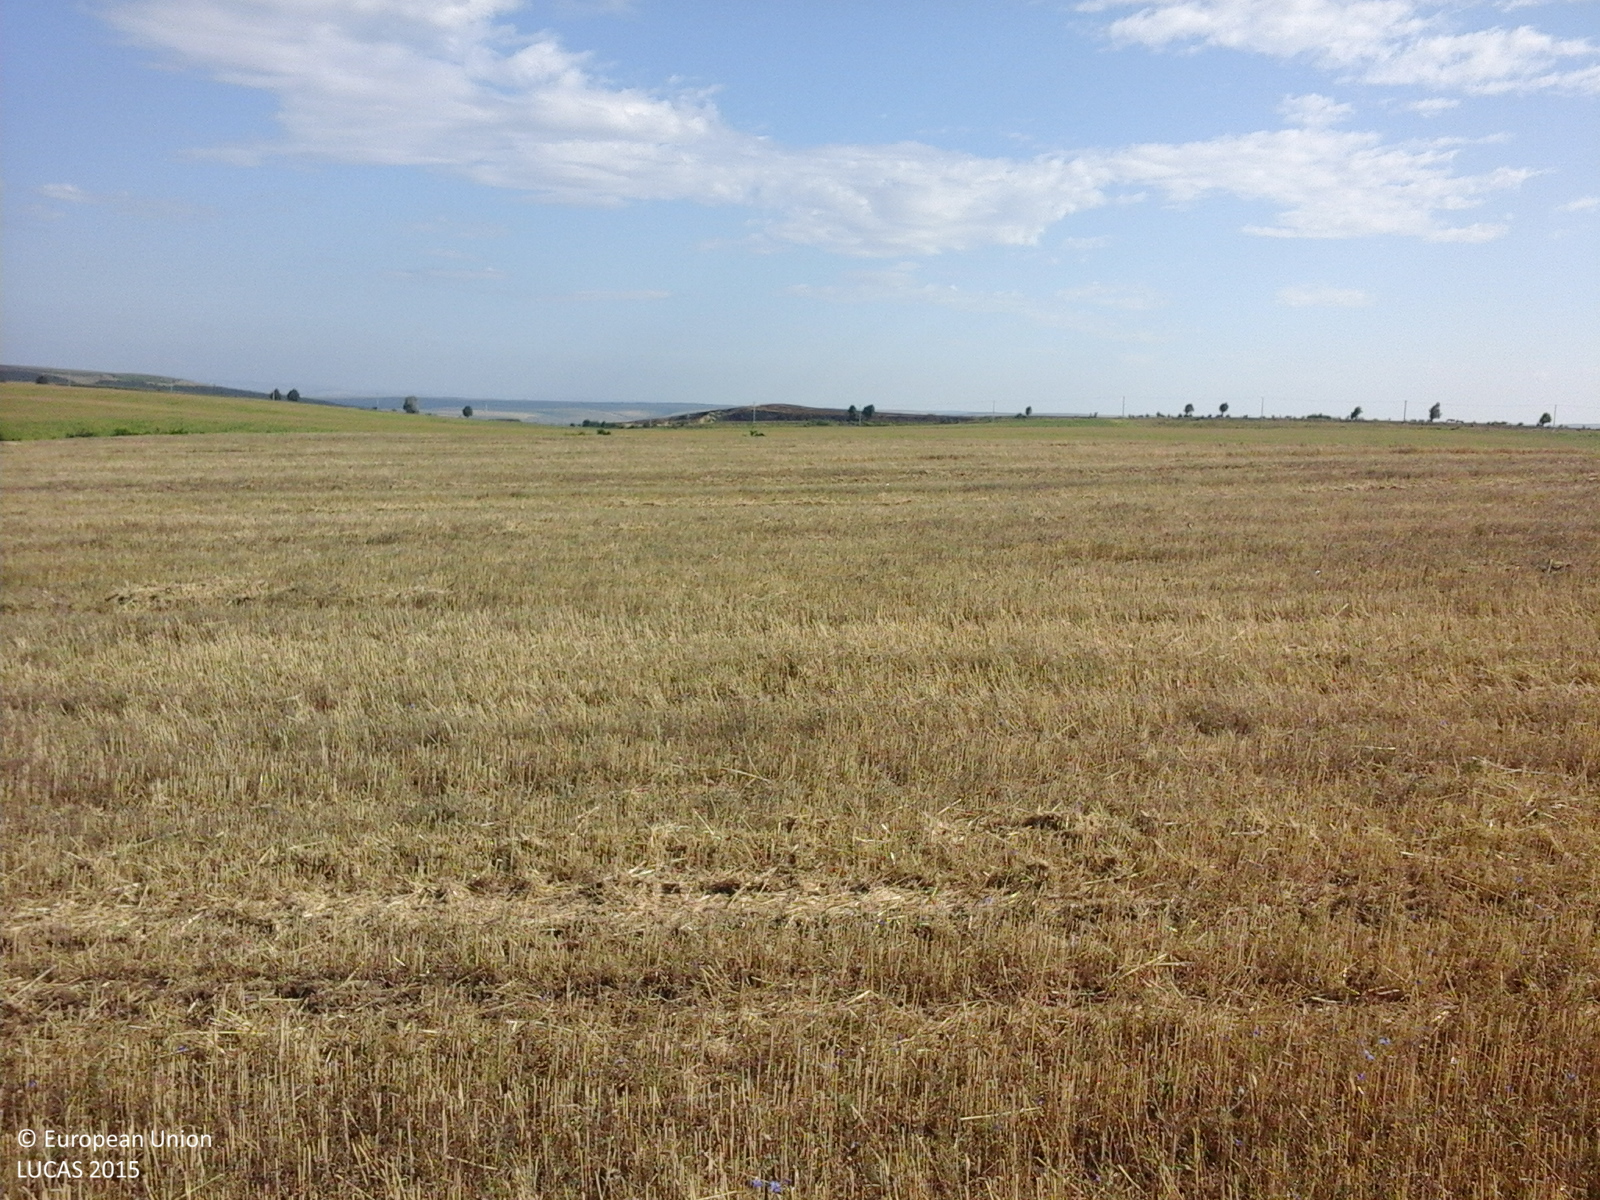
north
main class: Cropland
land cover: Common wheat
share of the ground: > 75 %
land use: Agriculture (excluding fallow land and kitchen gardens)
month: July
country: RO
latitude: 46.0956
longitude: 27.6916
